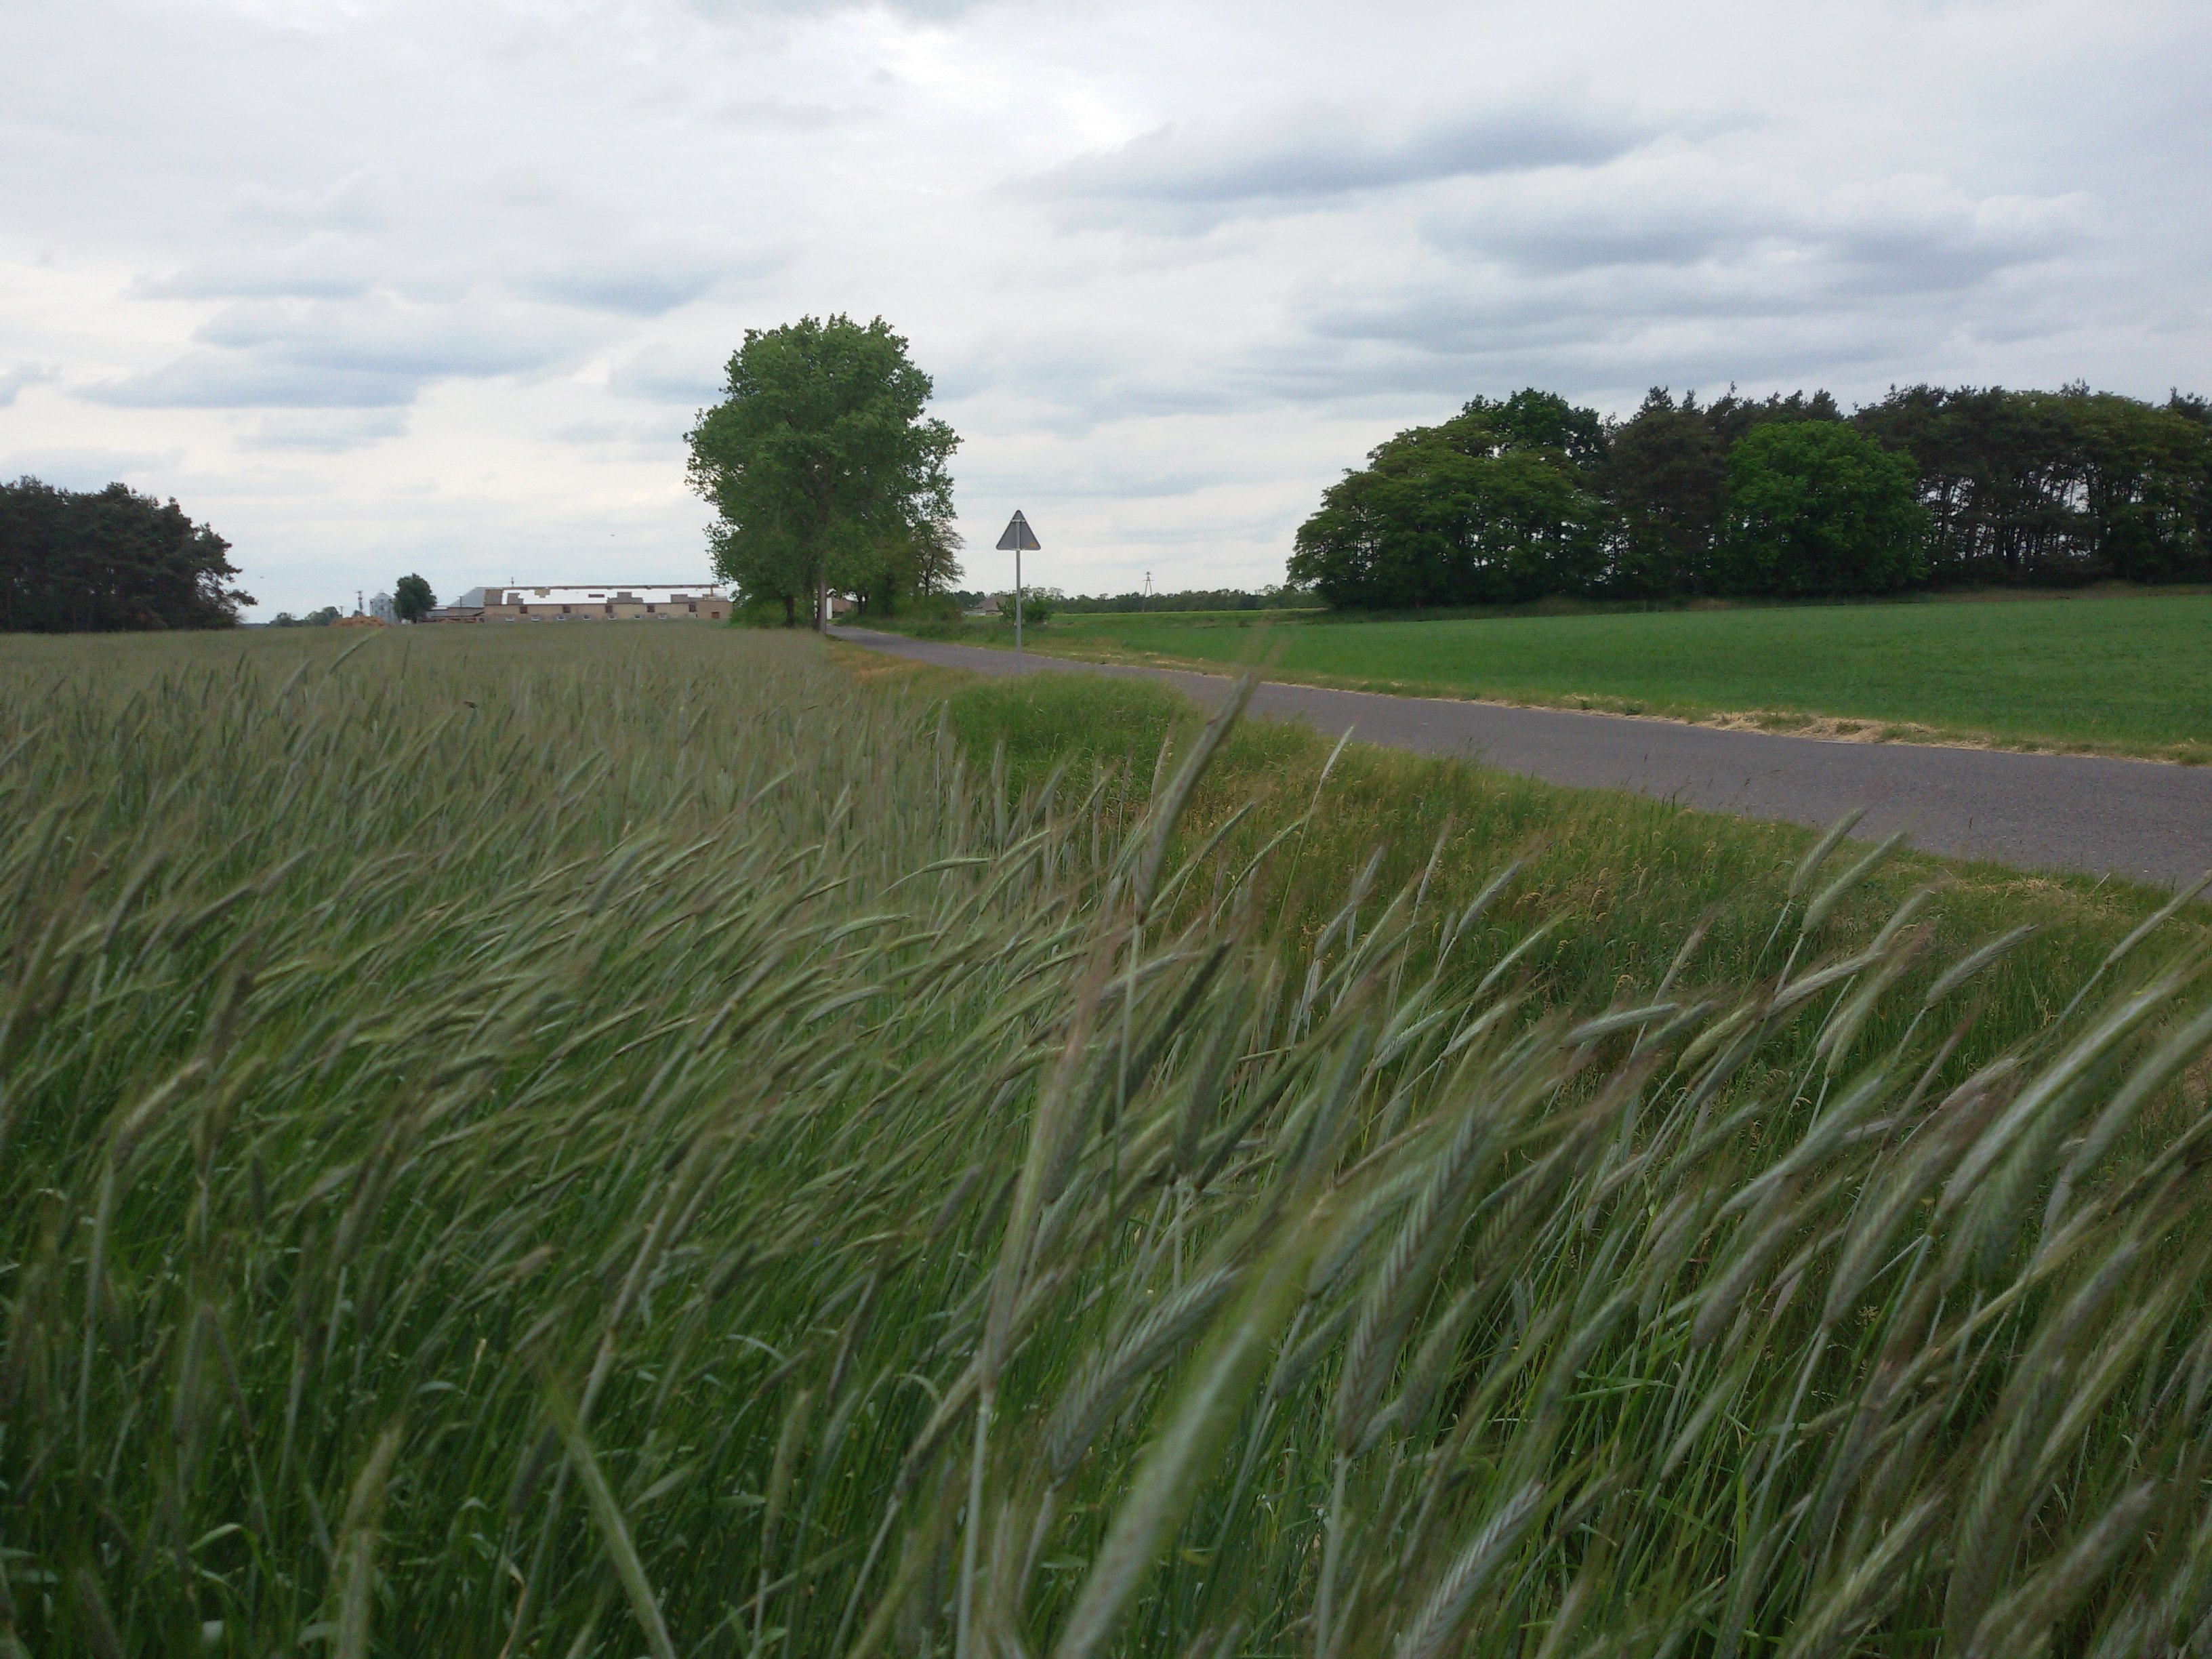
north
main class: Cropland
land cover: Rye
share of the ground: > 75 %
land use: Agriculture (excluding fallow land and kitchen gardens)
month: May
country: PL
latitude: 52.1273
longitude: 17.1243
